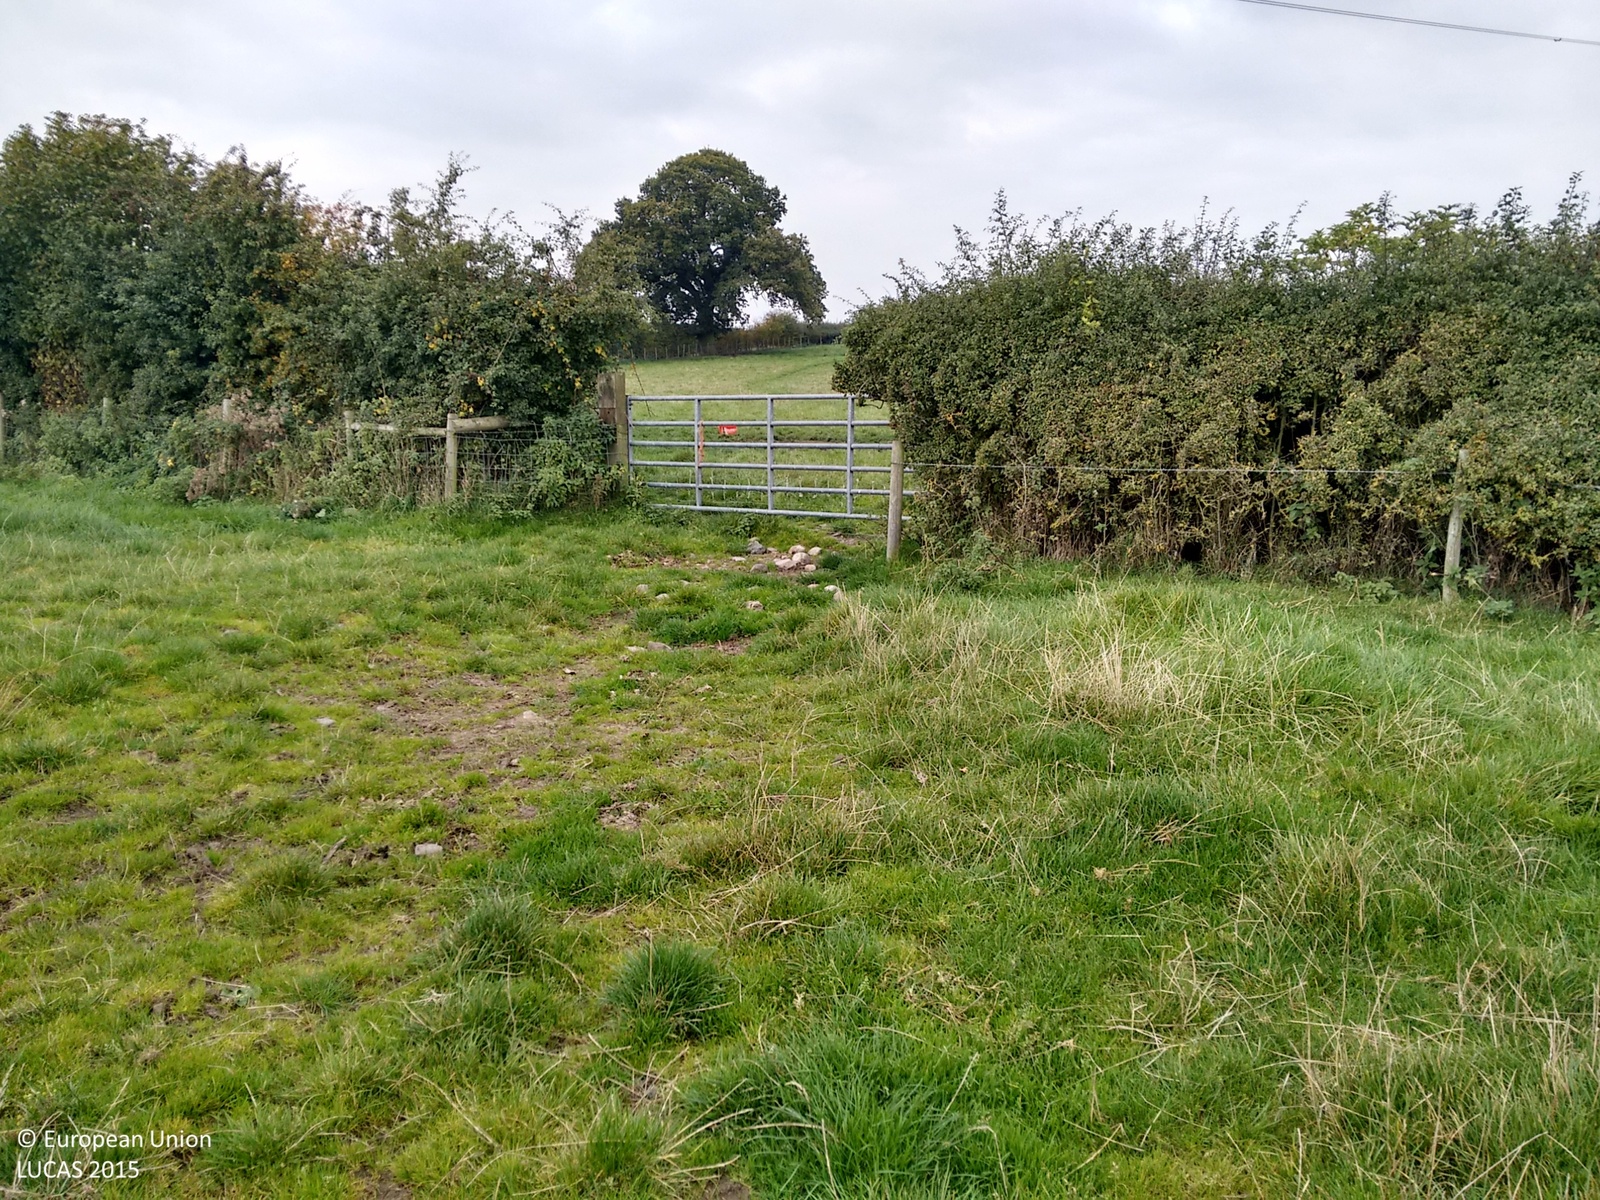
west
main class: Grassland
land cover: Grassland without tree/shrub cover
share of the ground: > 75 %
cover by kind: herbaceous plants 100 %
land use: Agriculture (excluding fallow land and kitchen gardens)
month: October
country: GB
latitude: 52.6684
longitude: -2.5927
